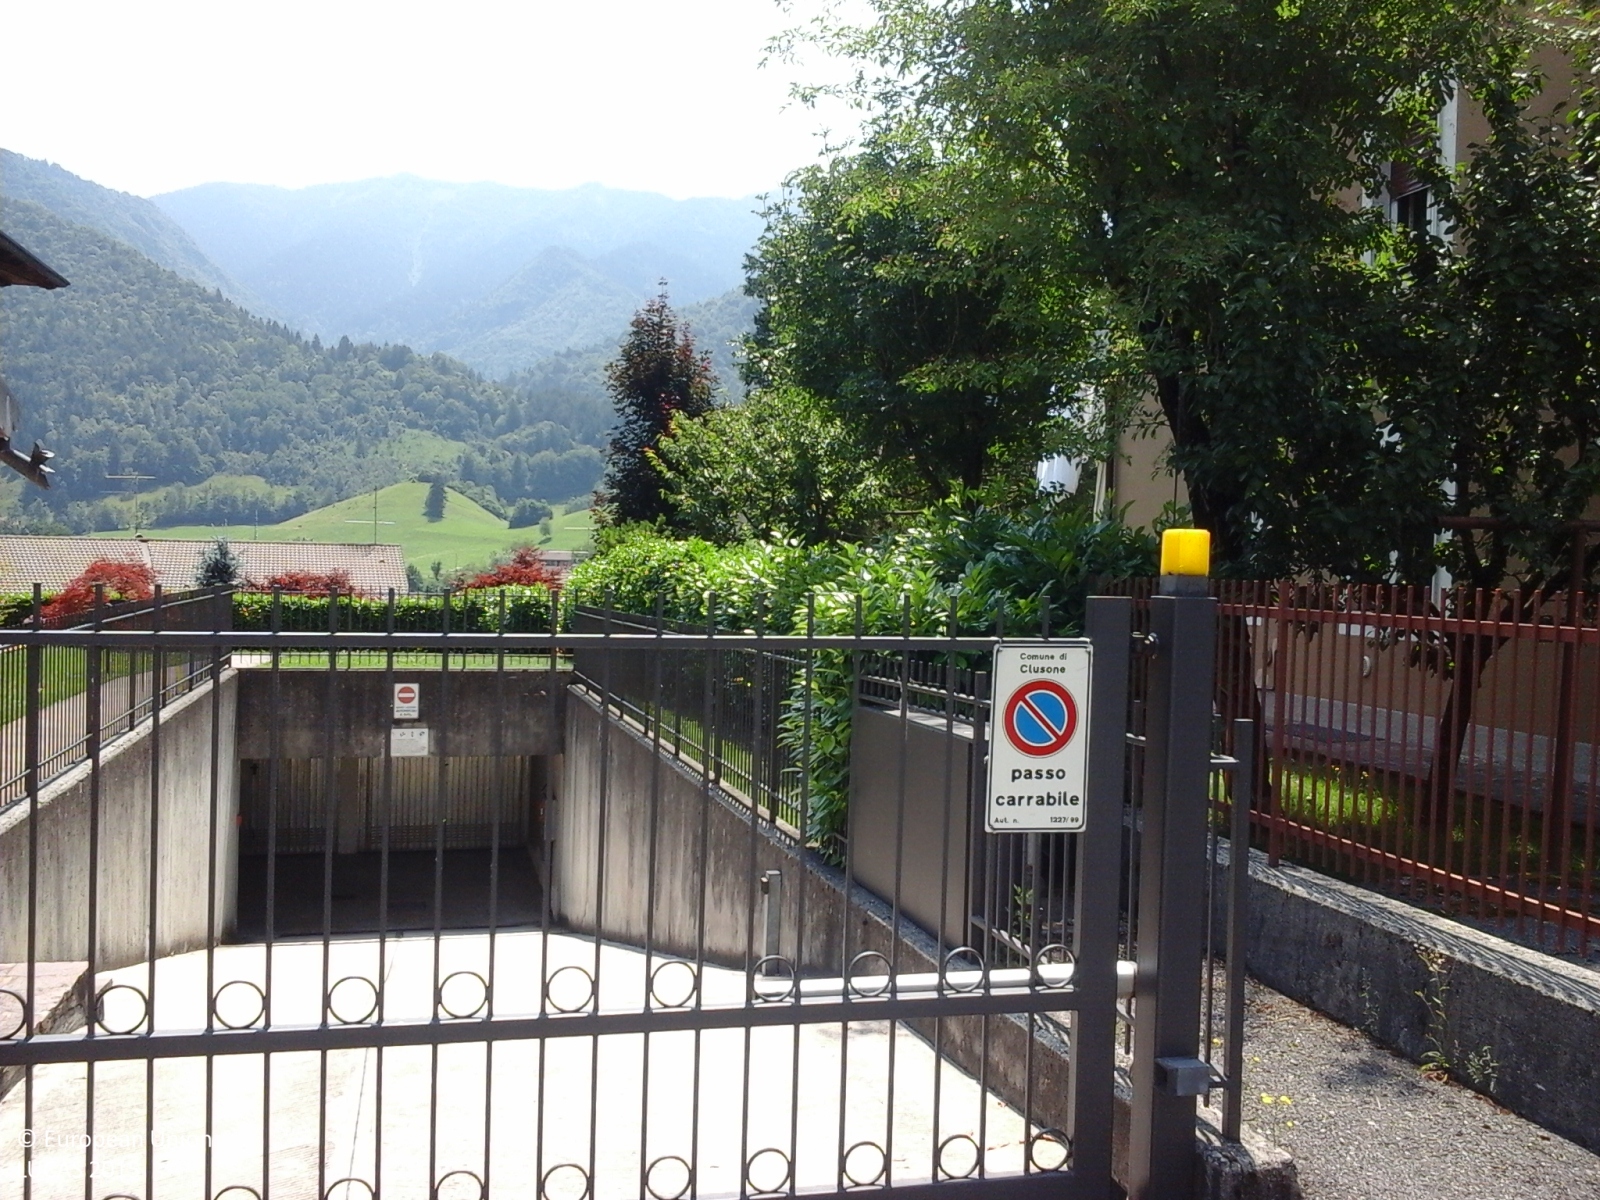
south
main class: Grassland
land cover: Grassland without tree/shrub cover
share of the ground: > 75 %
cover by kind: herbaceous plants 100 %
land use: Residential
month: July
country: IT
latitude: 45.8828
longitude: 9.9357
